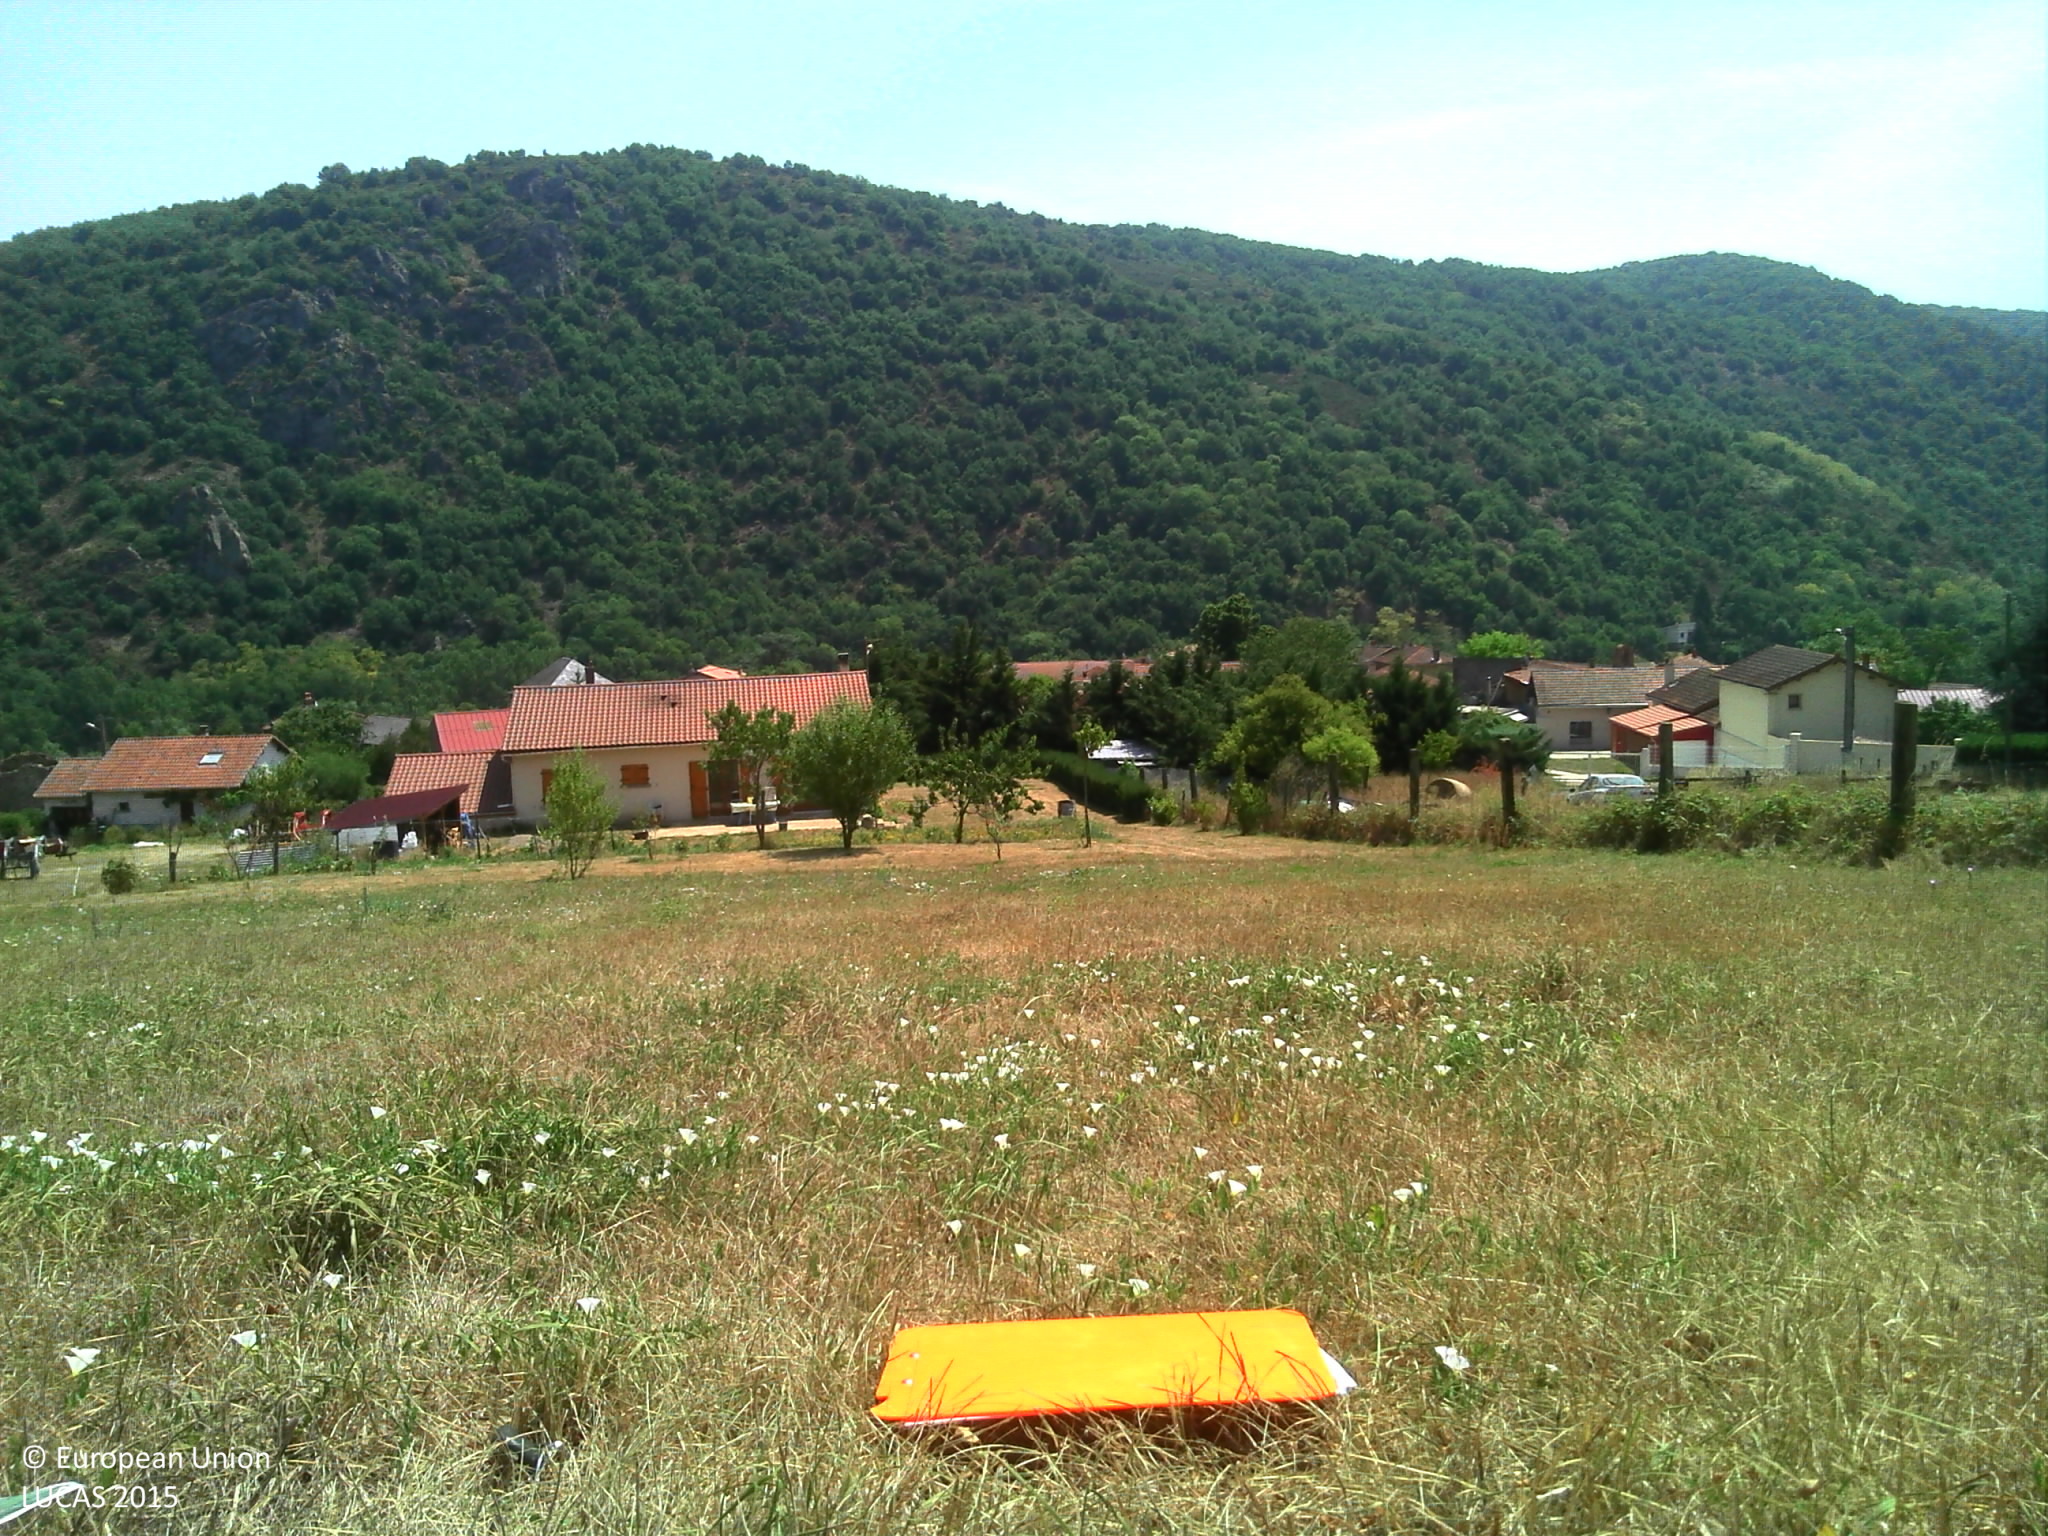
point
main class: Grassland
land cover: Grassland without tree/shrub cover
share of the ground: > 75 %
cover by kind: herbaceous plants 100 %
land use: Agriculture (excluding fallow land and kitchen gardens)
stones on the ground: < 10 %
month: July
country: FR
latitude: 45.3393
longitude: 3.1997
